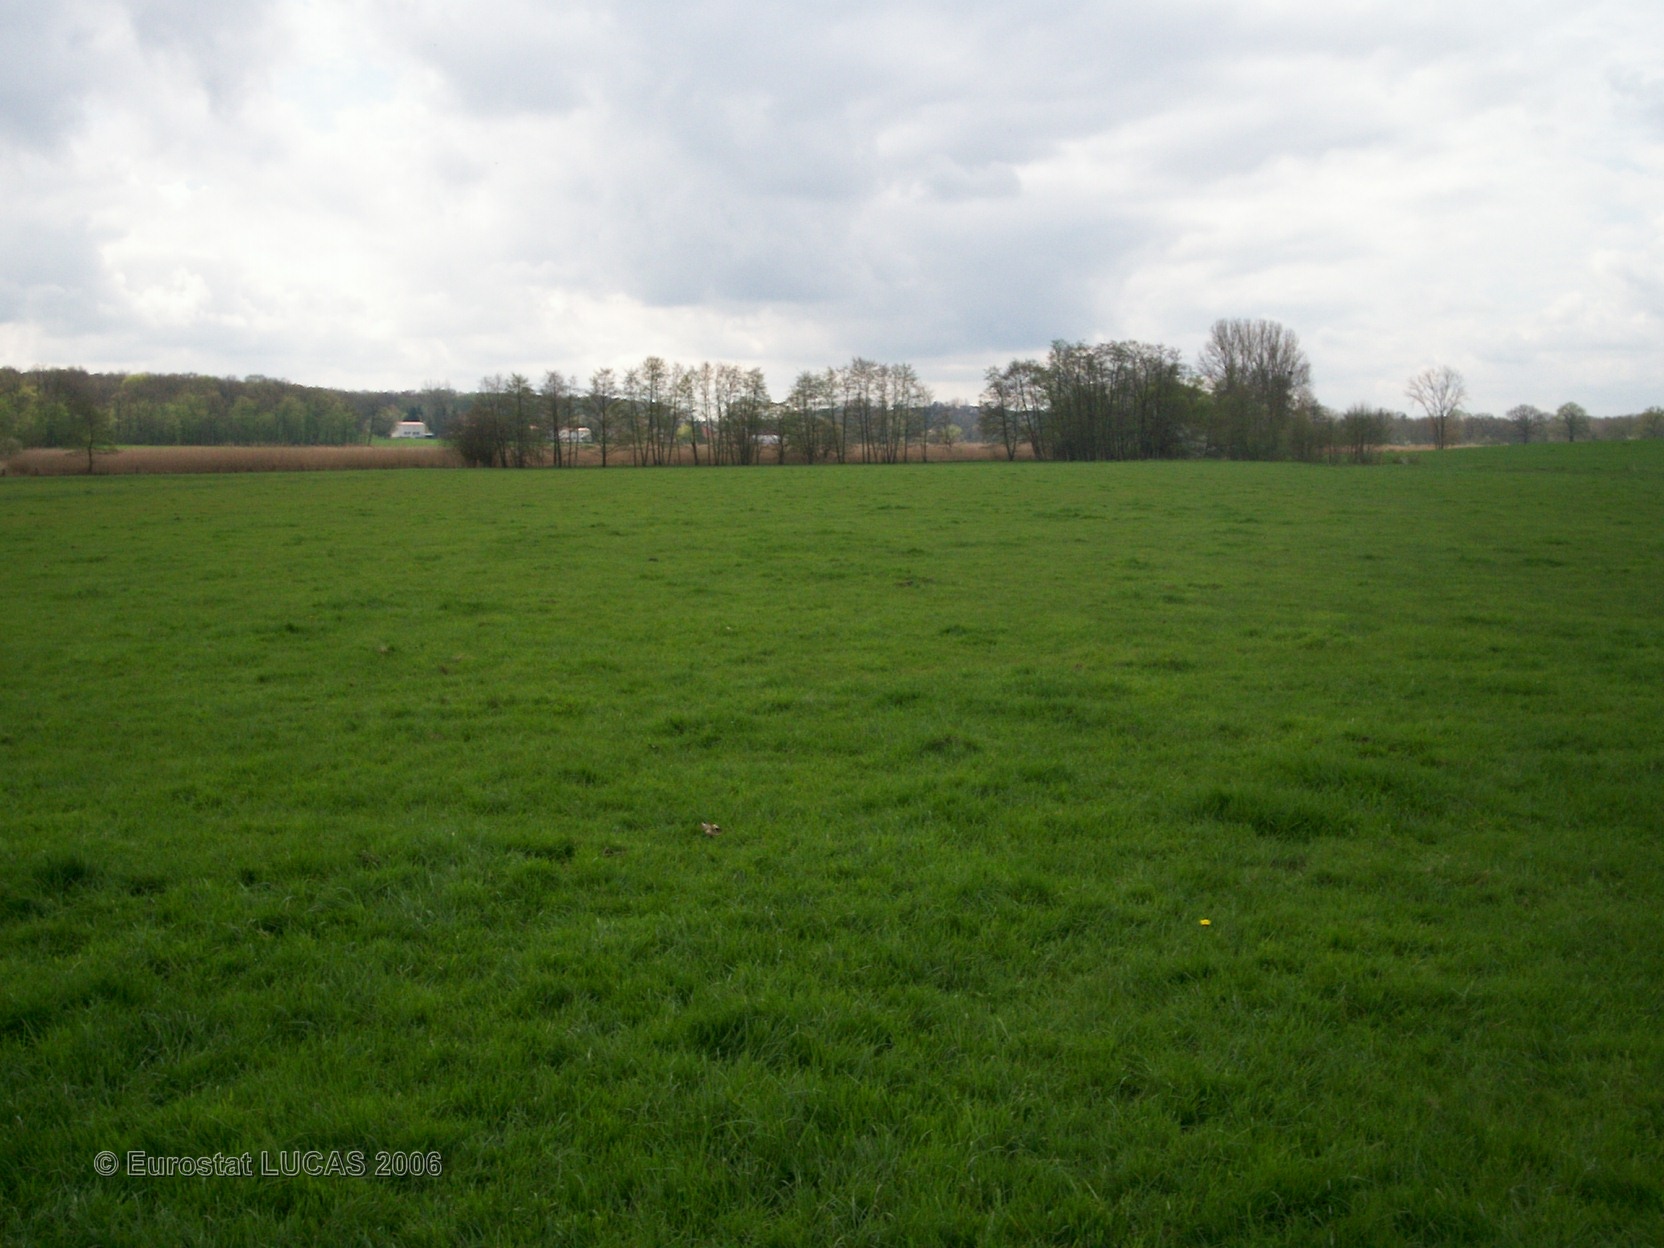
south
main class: Grassland
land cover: Grassland without tree/shrub cover
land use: Agriculture (excluding fallow land and kitchen gardens)
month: April
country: FR
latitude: 48.6996
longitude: 6.8075
